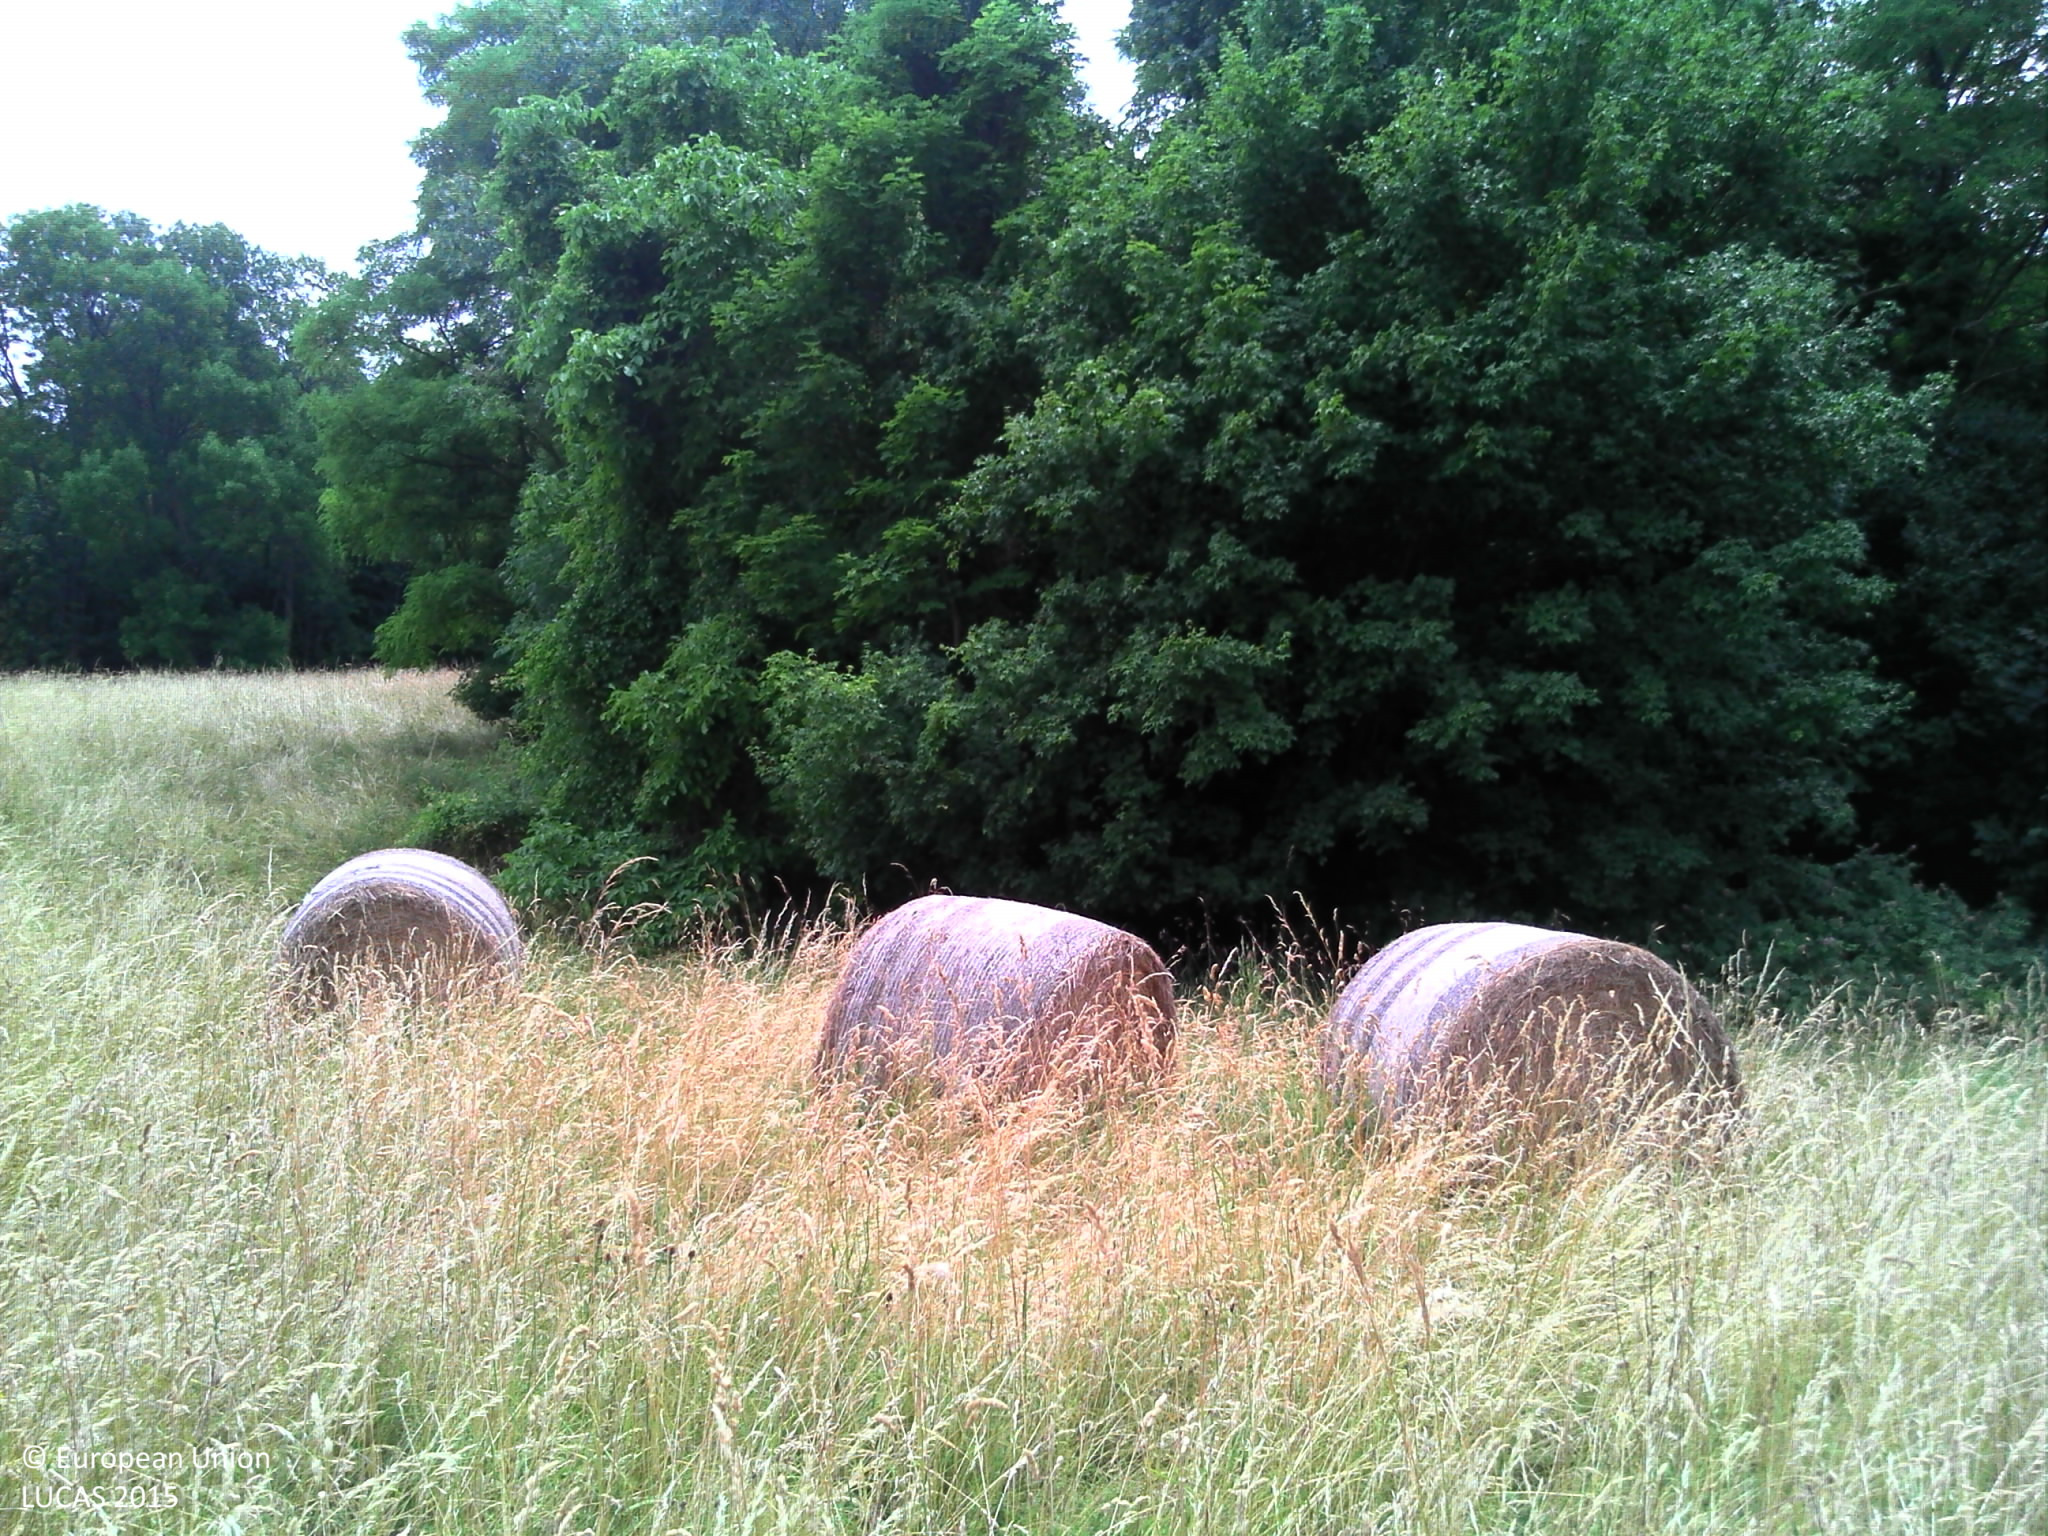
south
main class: Grassland
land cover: Grassland without tree/shrub cover
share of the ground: > 75 %
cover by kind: herbaceous plants 100 %
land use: Agriculture (excluding fallow land and kitchen gardens)
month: July
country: FR
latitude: 45.6588
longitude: 3.1084
